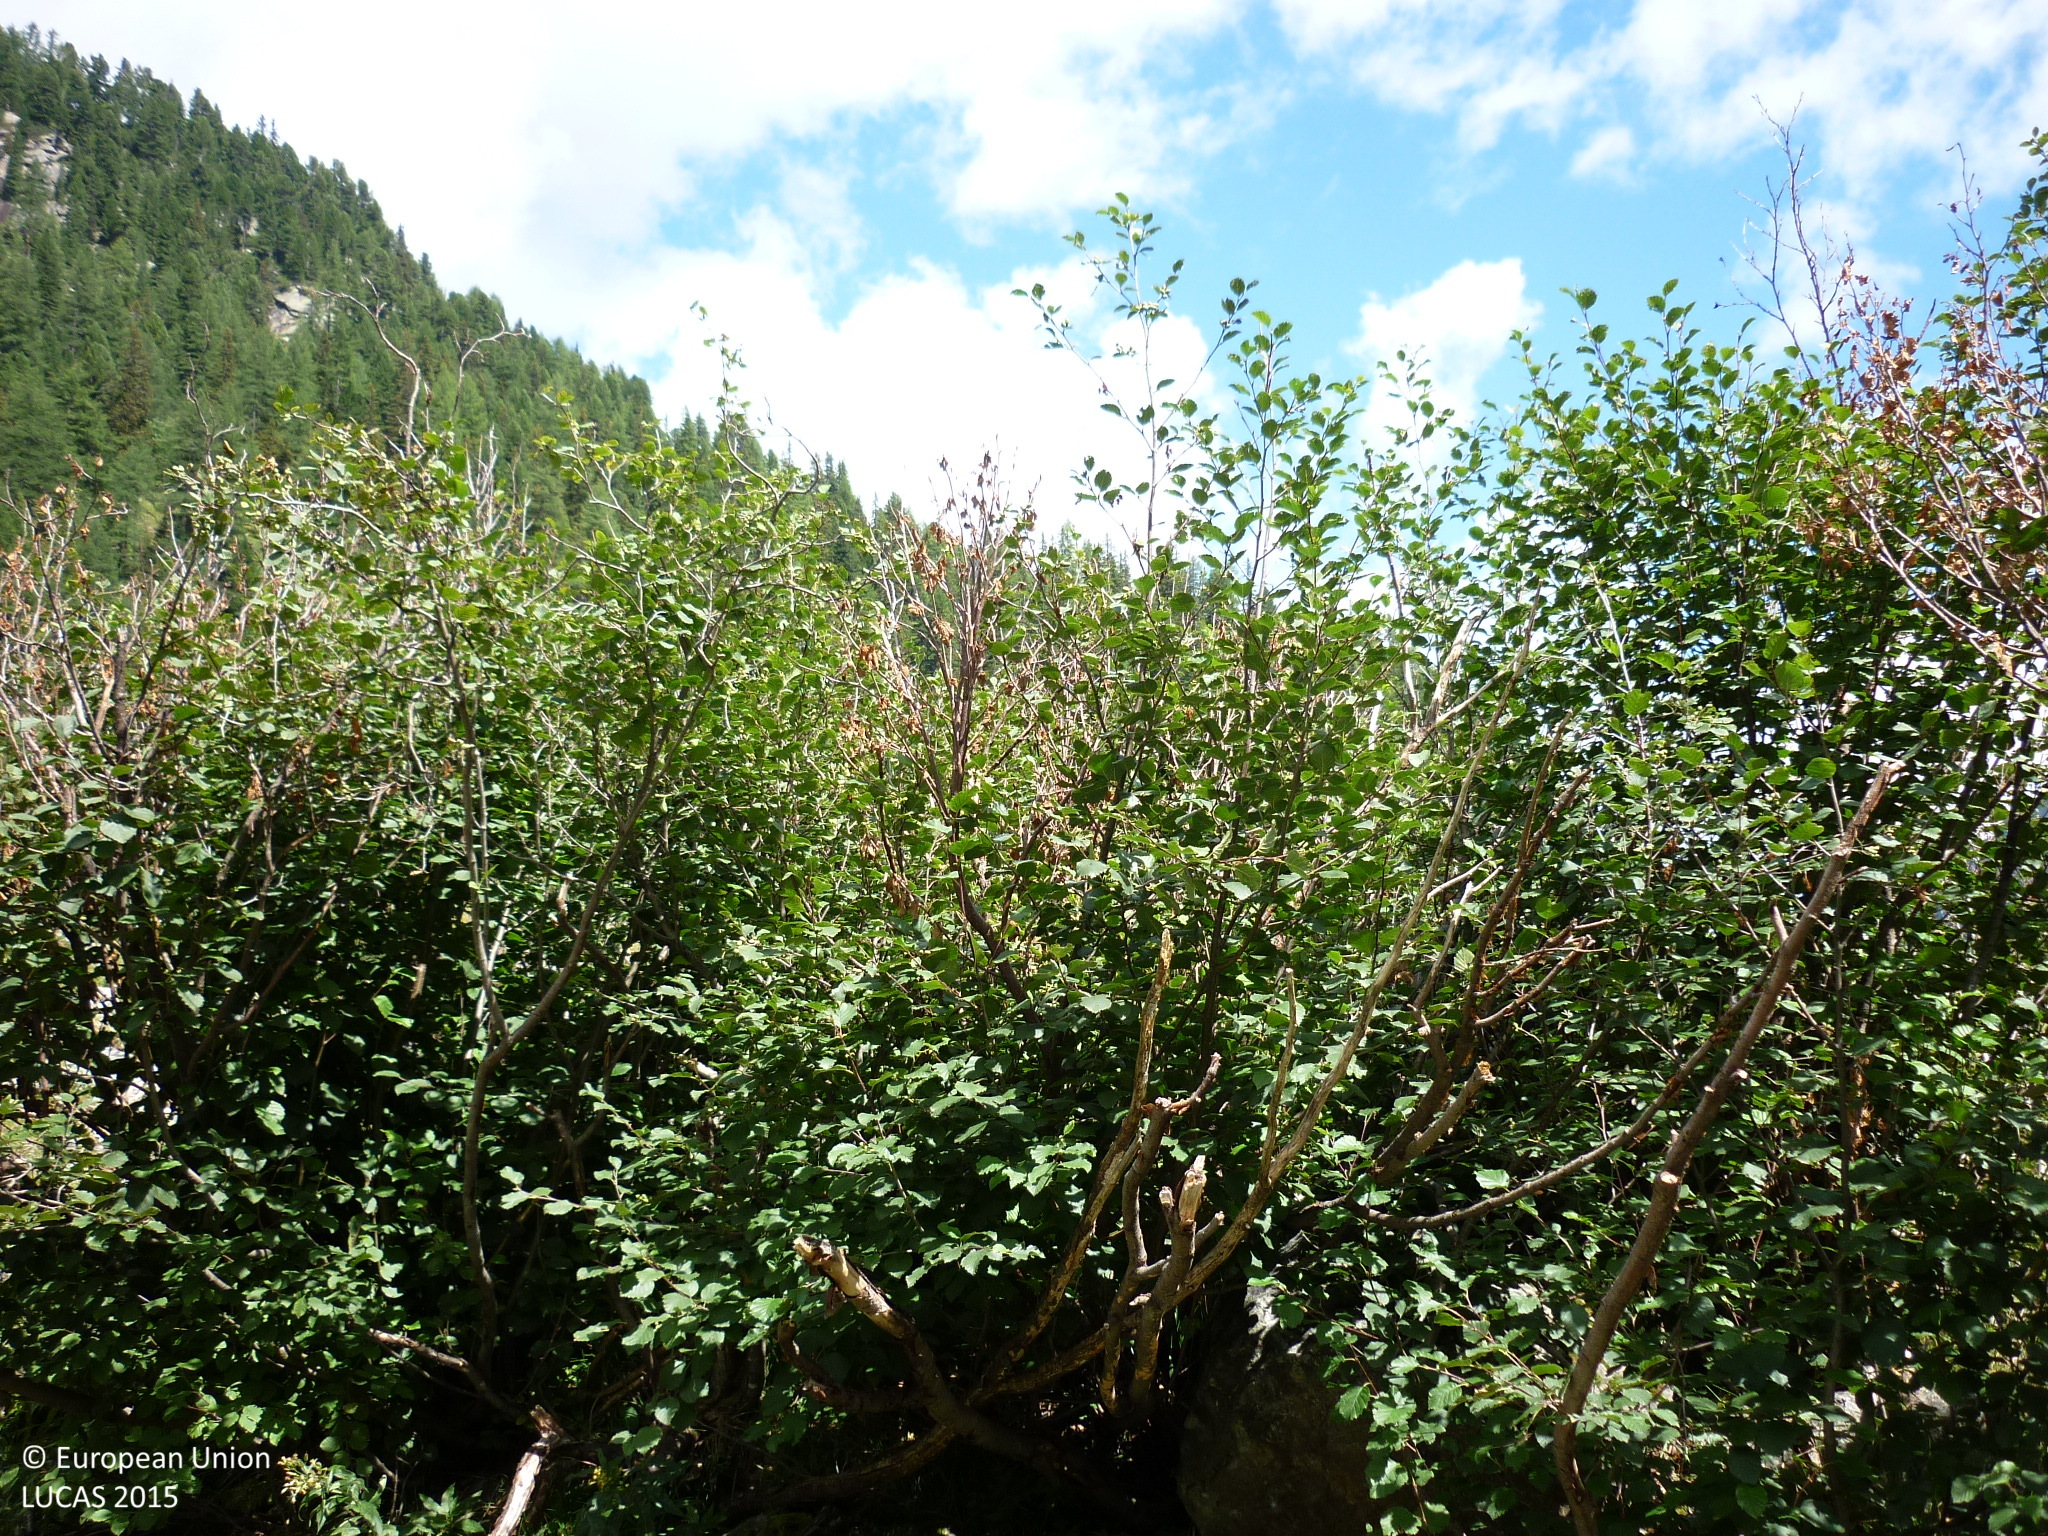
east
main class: Shrubland
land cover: Shrubland with sparse tree cover
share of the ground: > 75 %
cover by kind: consolidated bare surface 40 %, shrubs 30 %, herbaceous plants 15 %, lichens and mosses 10 %, coniferous forest trees 5 %
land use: Agriculture (excluding fallow land and kitchen gardens)
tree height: < 5 m
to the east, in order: Shrubland with sparse tree cover; Rivers and streams; Grassland with sparse tree/shrub cover; Inland fresh running water; Broadleaved woodland; Grassland with sparse tree/shrub cover; Spruce dominated mixed woodland; Spruce dominated coniferous woodland
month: August
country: AT
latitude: 46.9845
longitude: 13.3239
